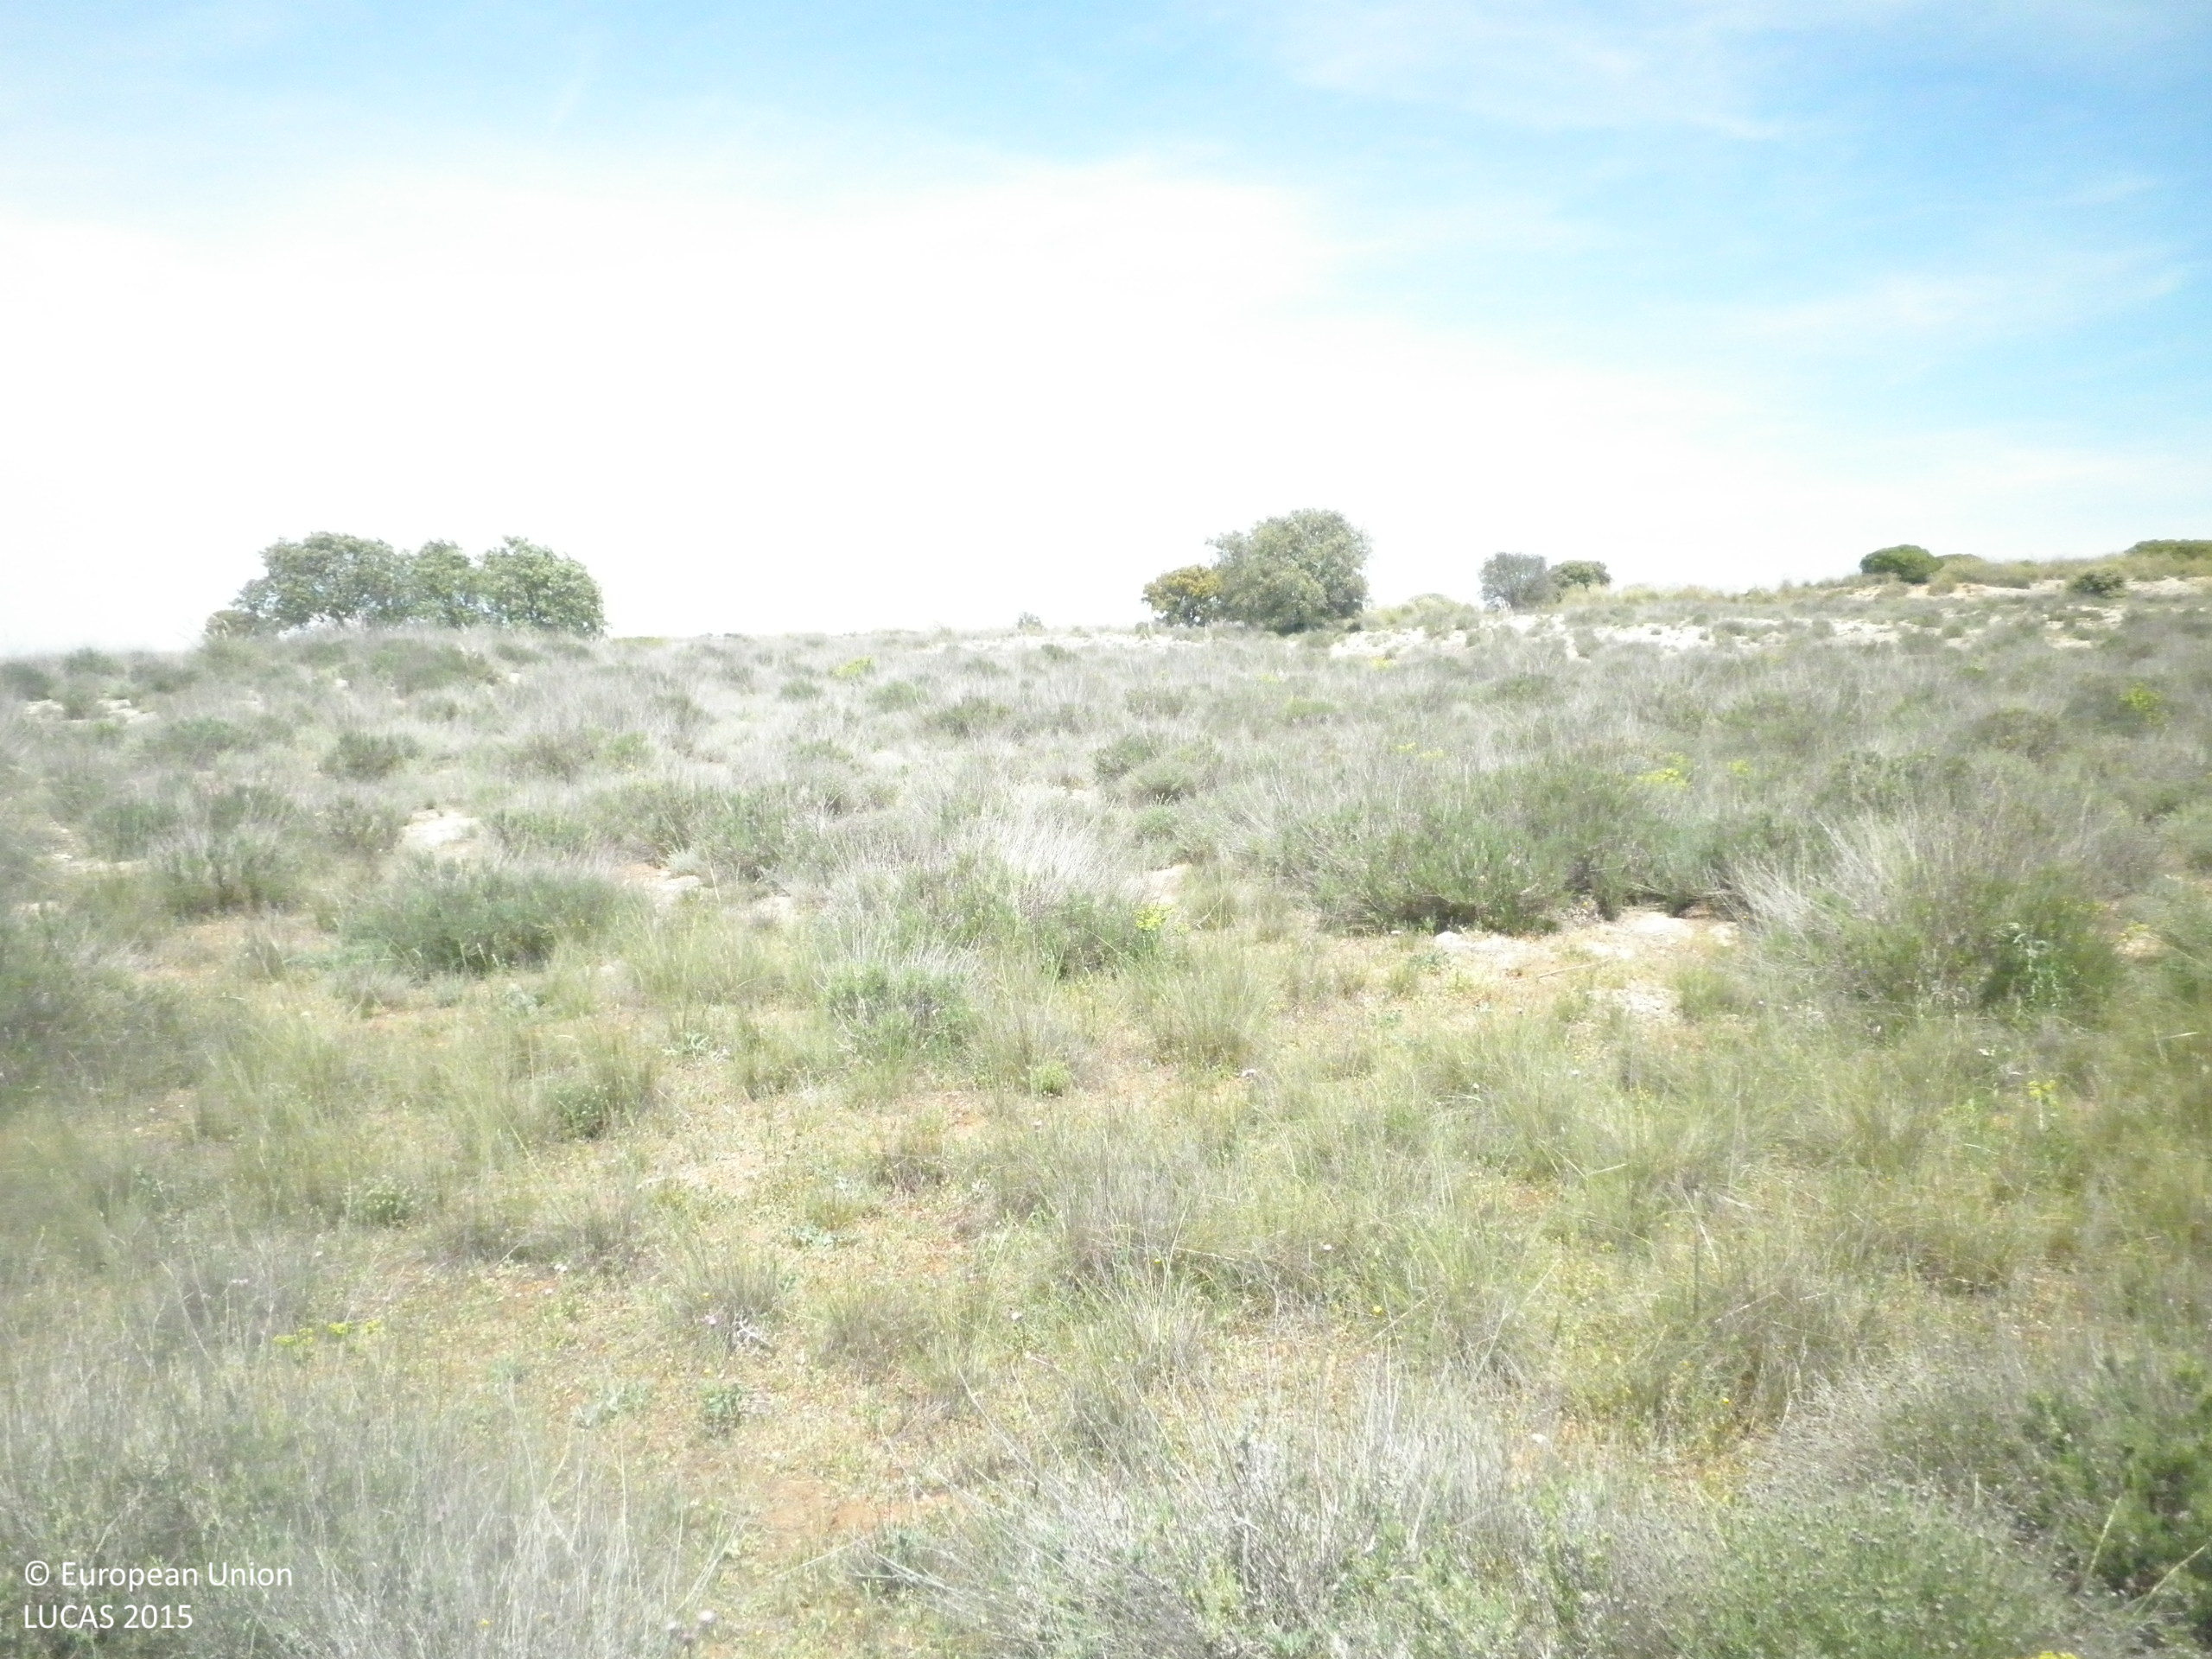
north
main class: Shrubland
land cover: Shrubland without tree cover
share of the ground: 50 - 75 %
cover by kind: unconsolidated bare surface 40 %, shrubs 30 %, herbaceous plants 30 %
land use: Semi-natural and natural areas not in use
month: May
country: ES
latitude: 39.6181
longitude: -2.7245
